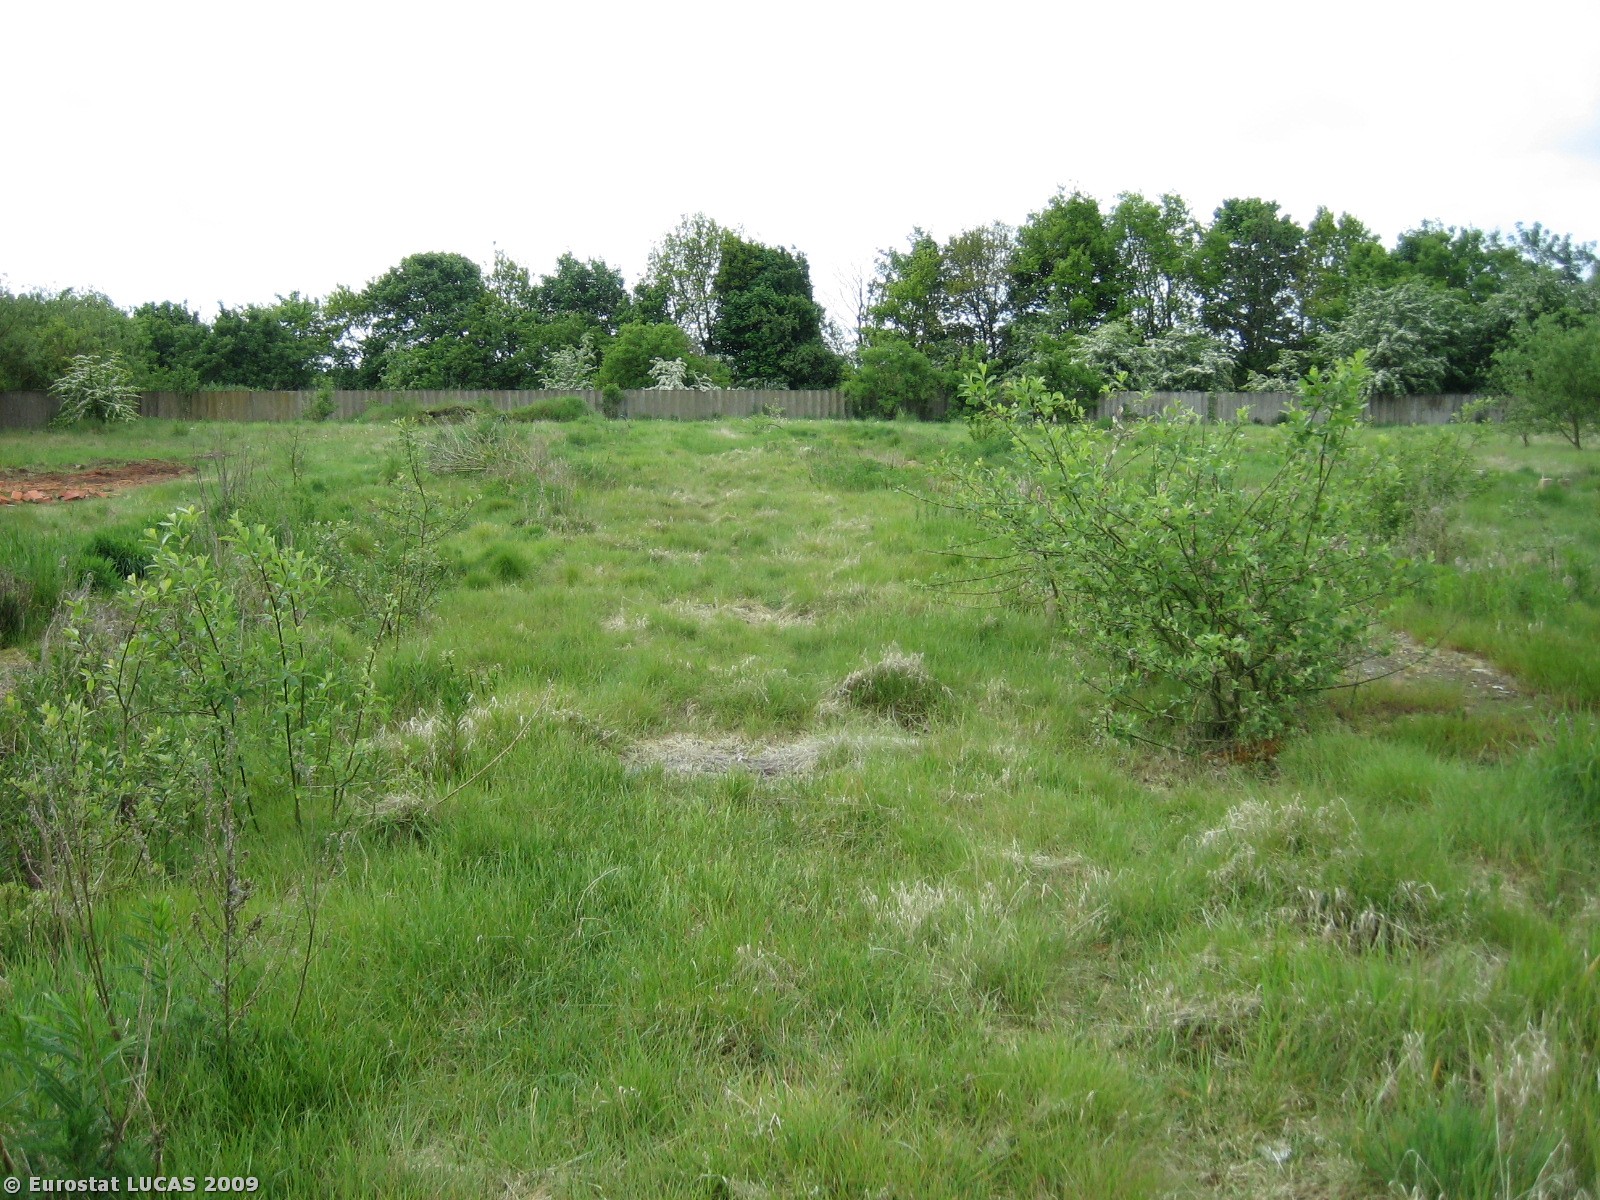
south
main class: Grassland
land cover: Grassland with sparse tree/shrub cover
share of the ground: > 75 %
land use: Logistics and storage
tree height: > 5 m
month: May
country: DK
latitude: 56.0922
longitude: 8.7959
